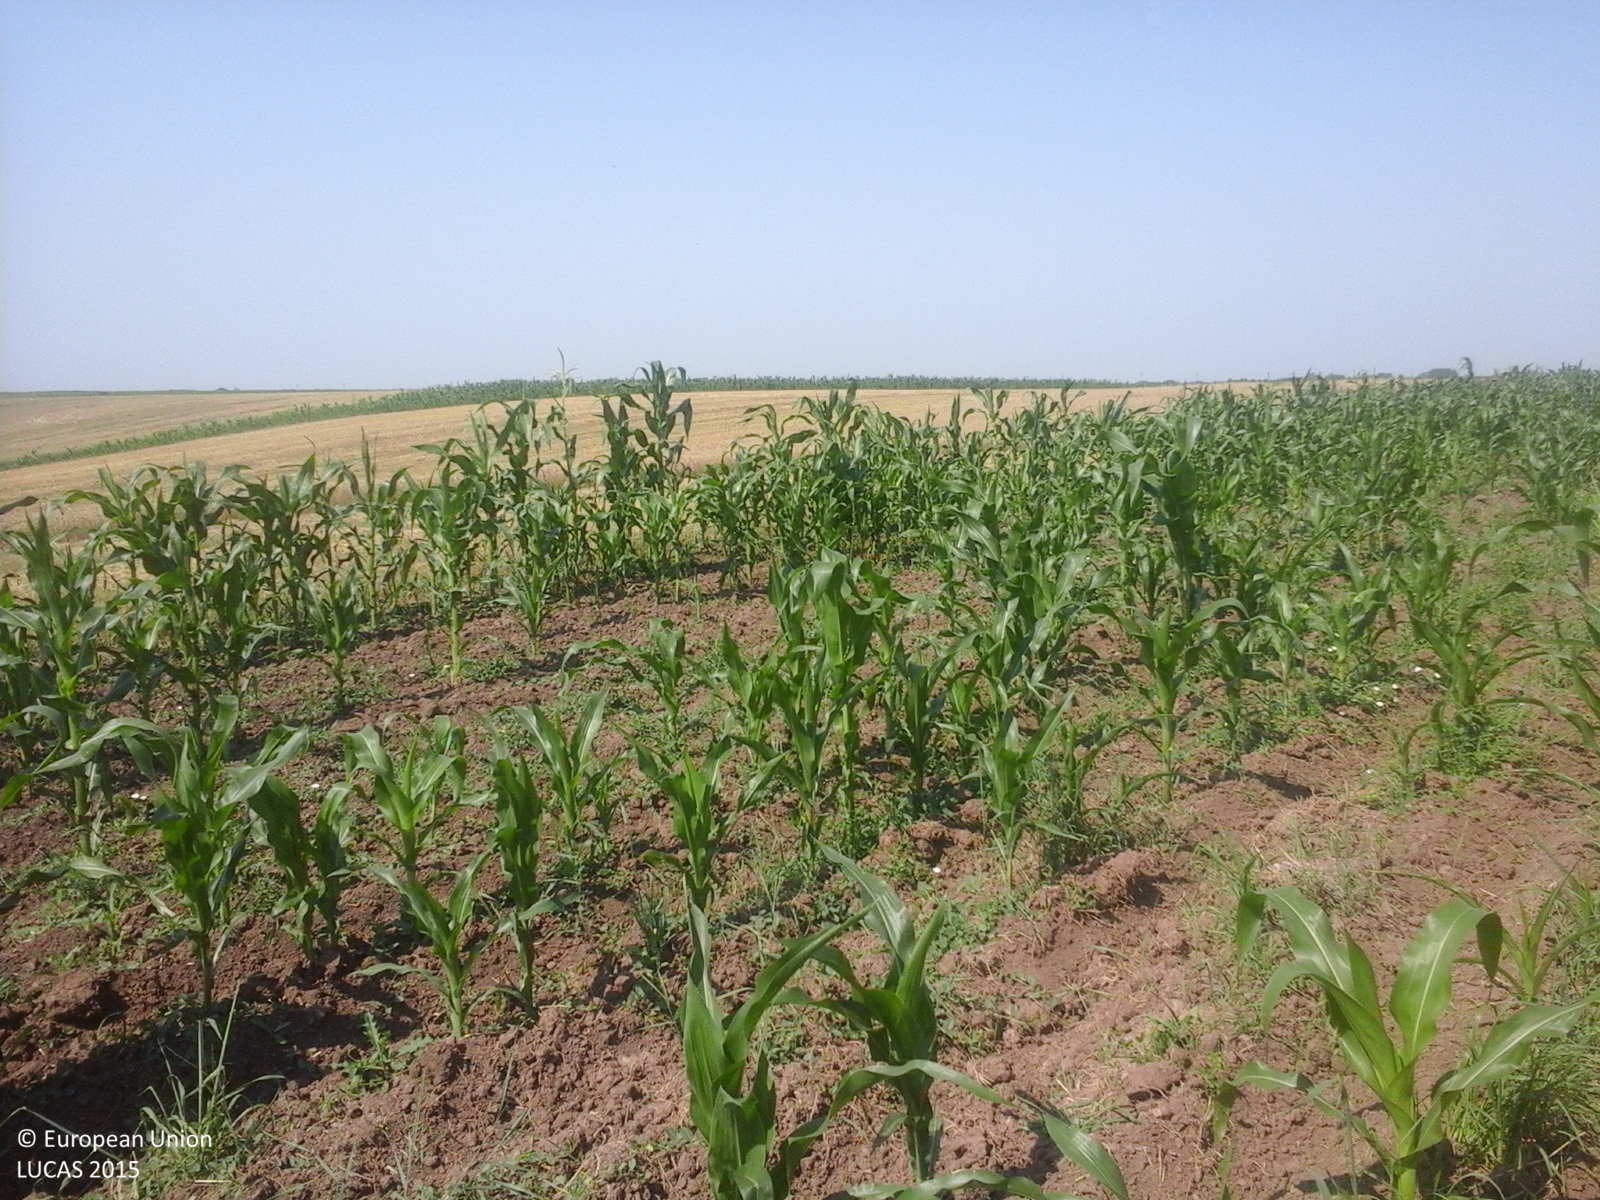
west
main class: Cropland
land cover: Common wheat
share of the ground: > 75 %
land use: Agriculture (excluding fallow land and kitchen gardens)
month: July
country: RO
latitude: 44.4906
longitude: 24.8022
